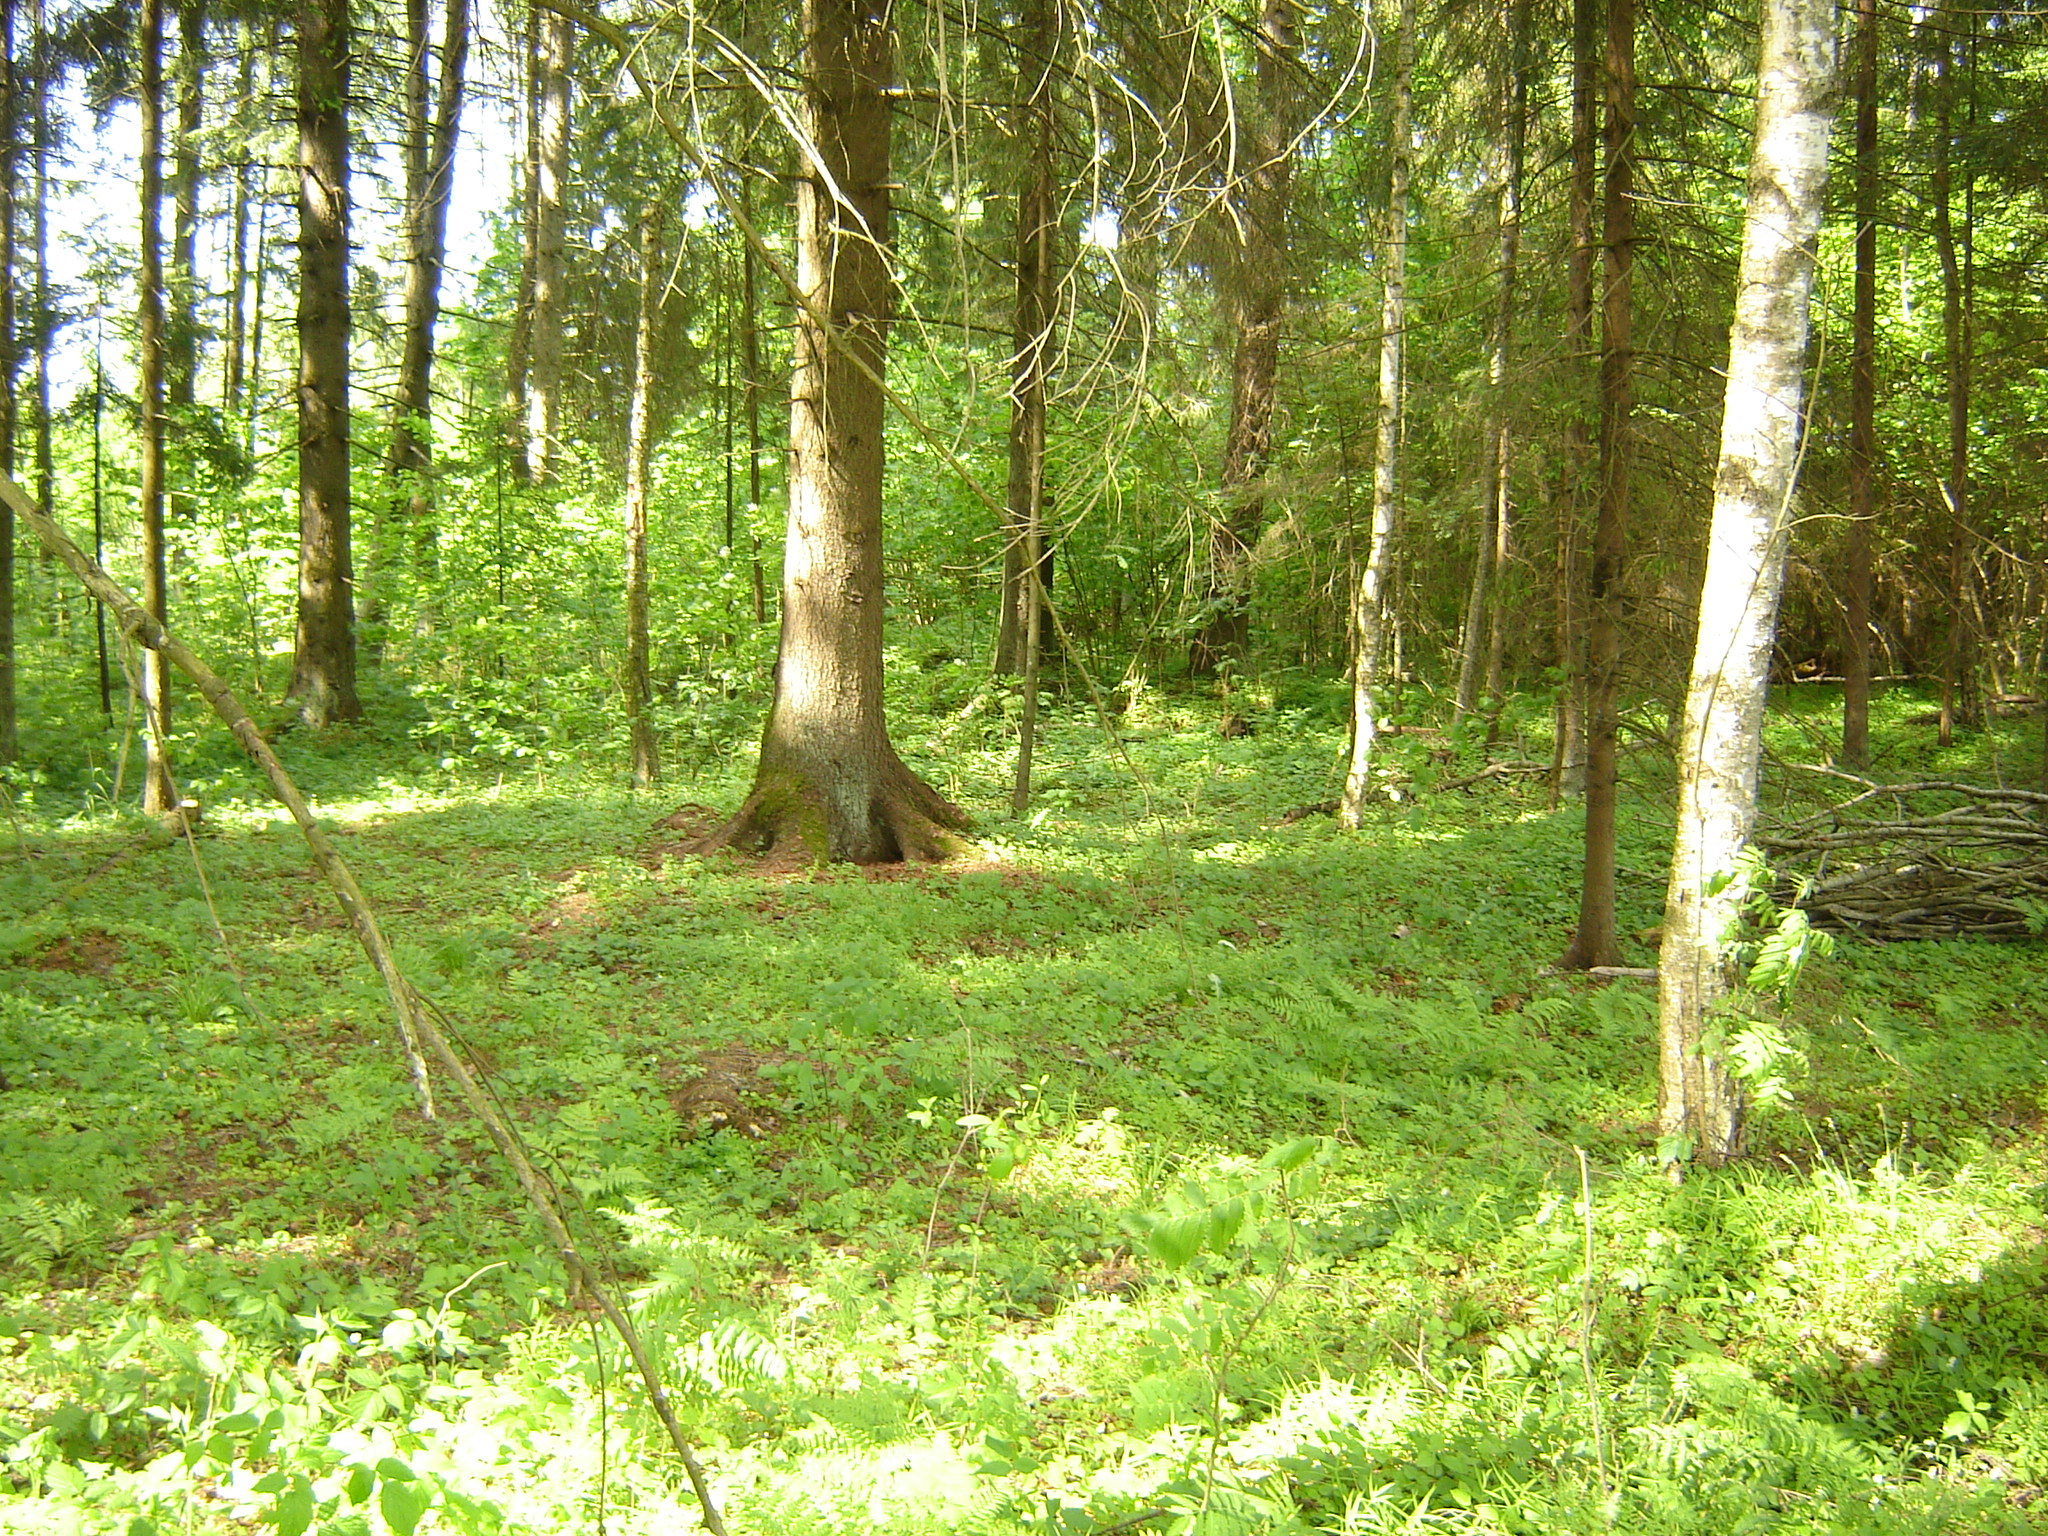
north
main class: Woodland
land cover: Spruce dominated coniferous woodland
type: hemiboreal forest and nemoral coniferous forest and mixed broadleaved-coniferous forest
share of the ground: > 75 %
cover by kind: coniferous forest trees 80 %, broadleaved forest trees 10 %, herbaceous plants 10 %
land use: Forestry
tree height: > 5 m
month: June
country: LT
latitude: 55.9083
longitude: 25.2658
